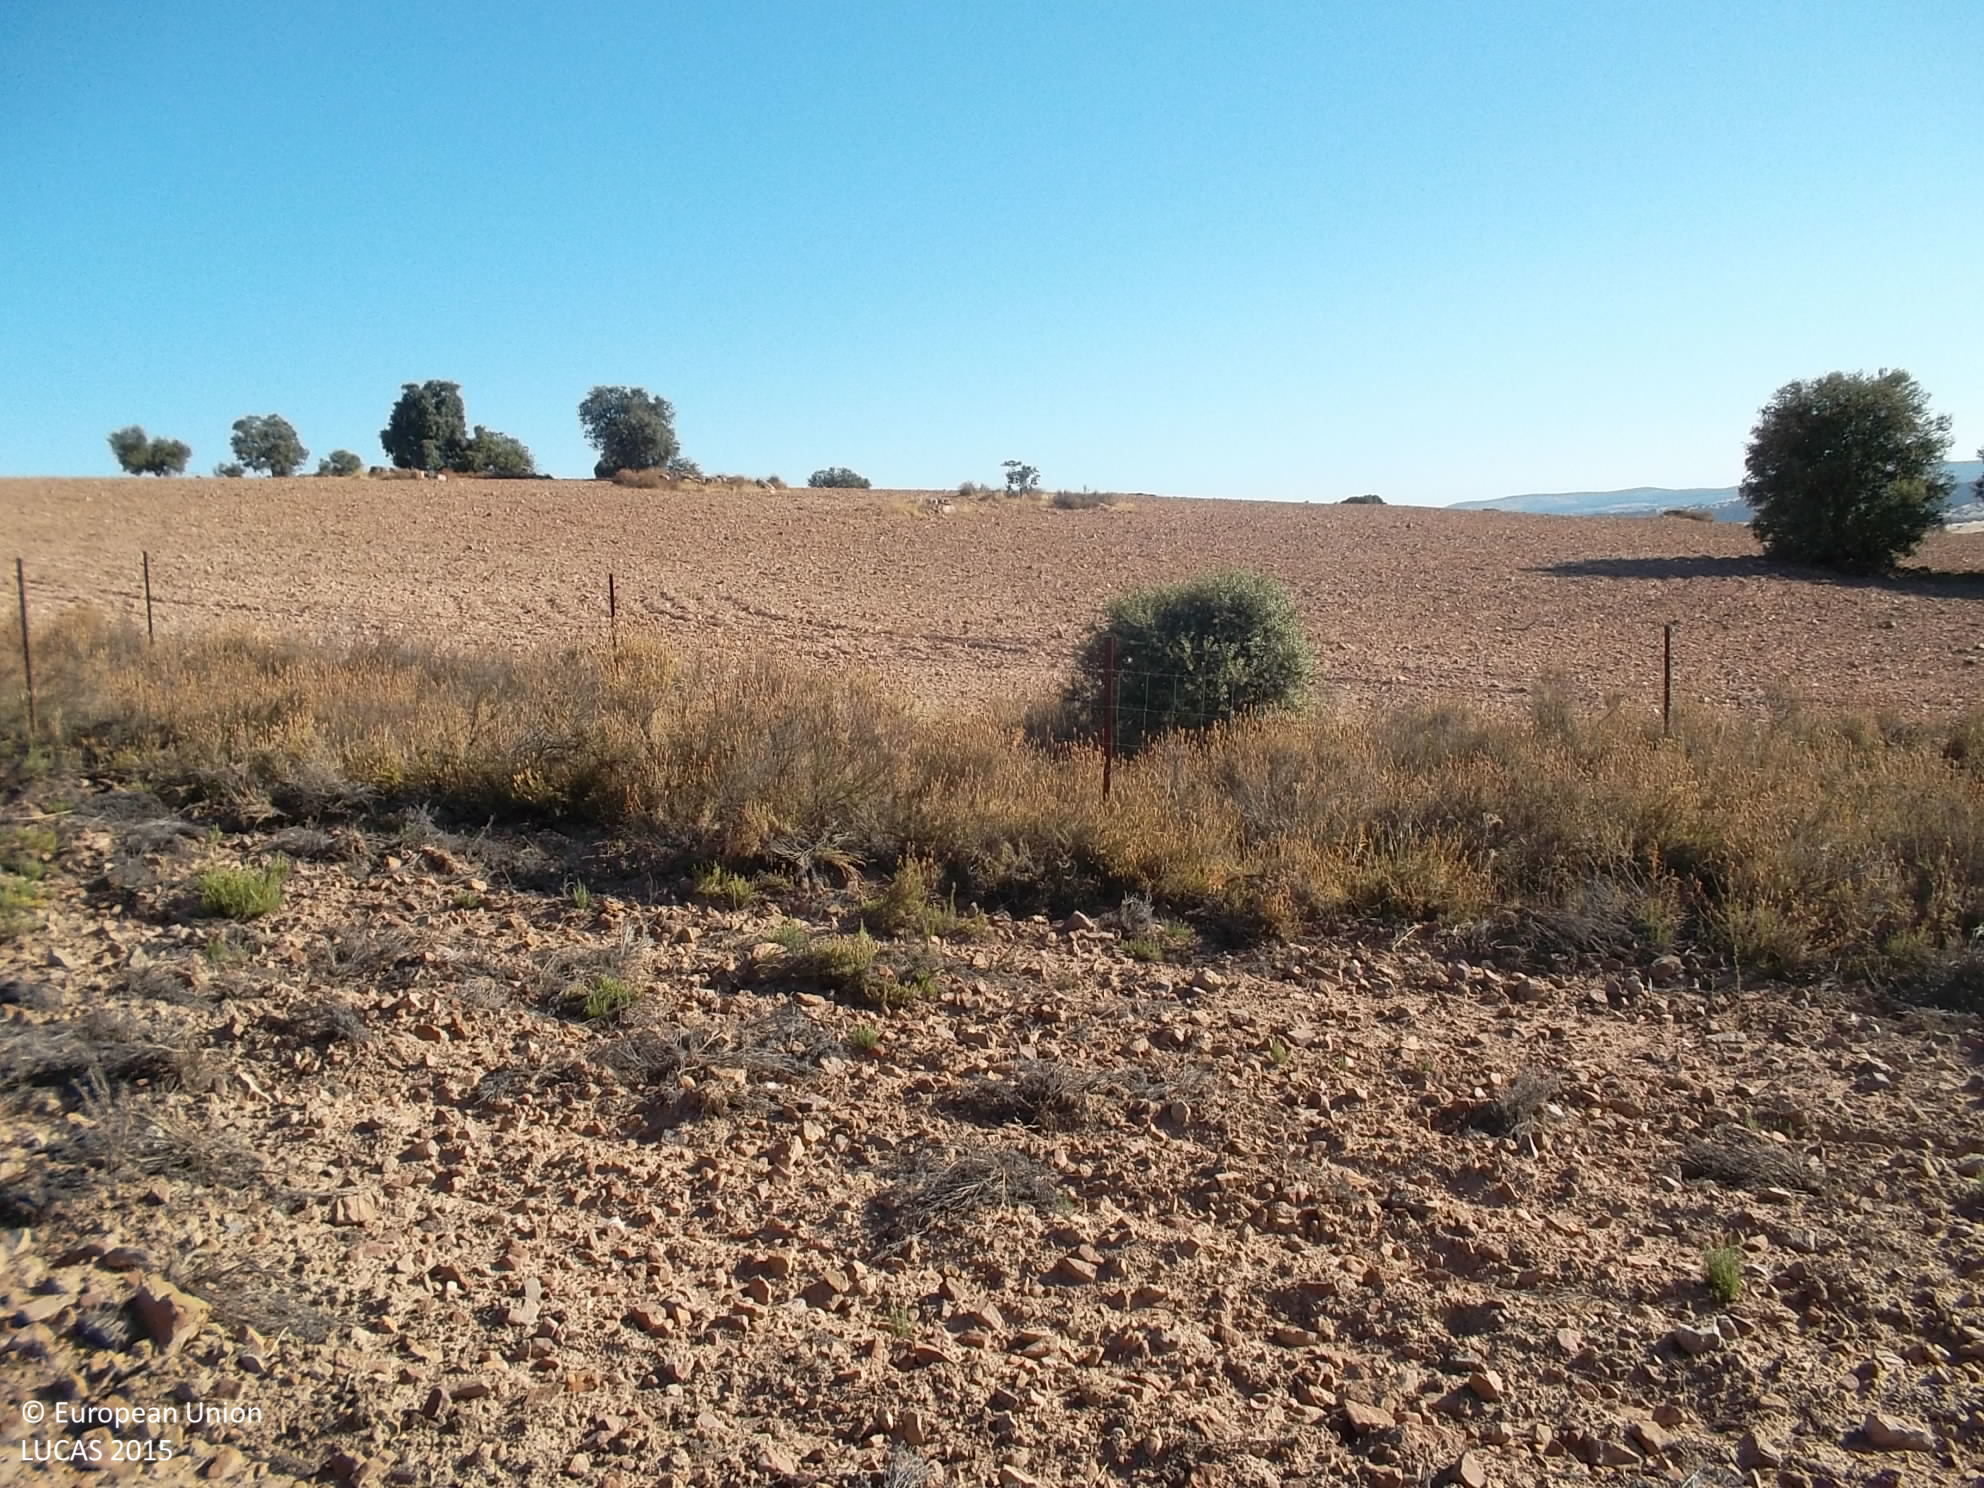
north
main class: Woodland
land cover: Broadleaved woodland
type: broadleaved evergreen forest
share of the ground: 10 - 25 %
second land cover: Grassland without tree/shrub cover
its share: 10 - 25 %
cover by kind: herbaceous plants 80 %, broadleaved forest trees 20 %
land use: Forestry
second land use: Agriculture (excluding fallow land and kitchen gardens)
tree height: > 5 m
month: July
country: ES
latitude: 38.4909
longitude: -5.8513
